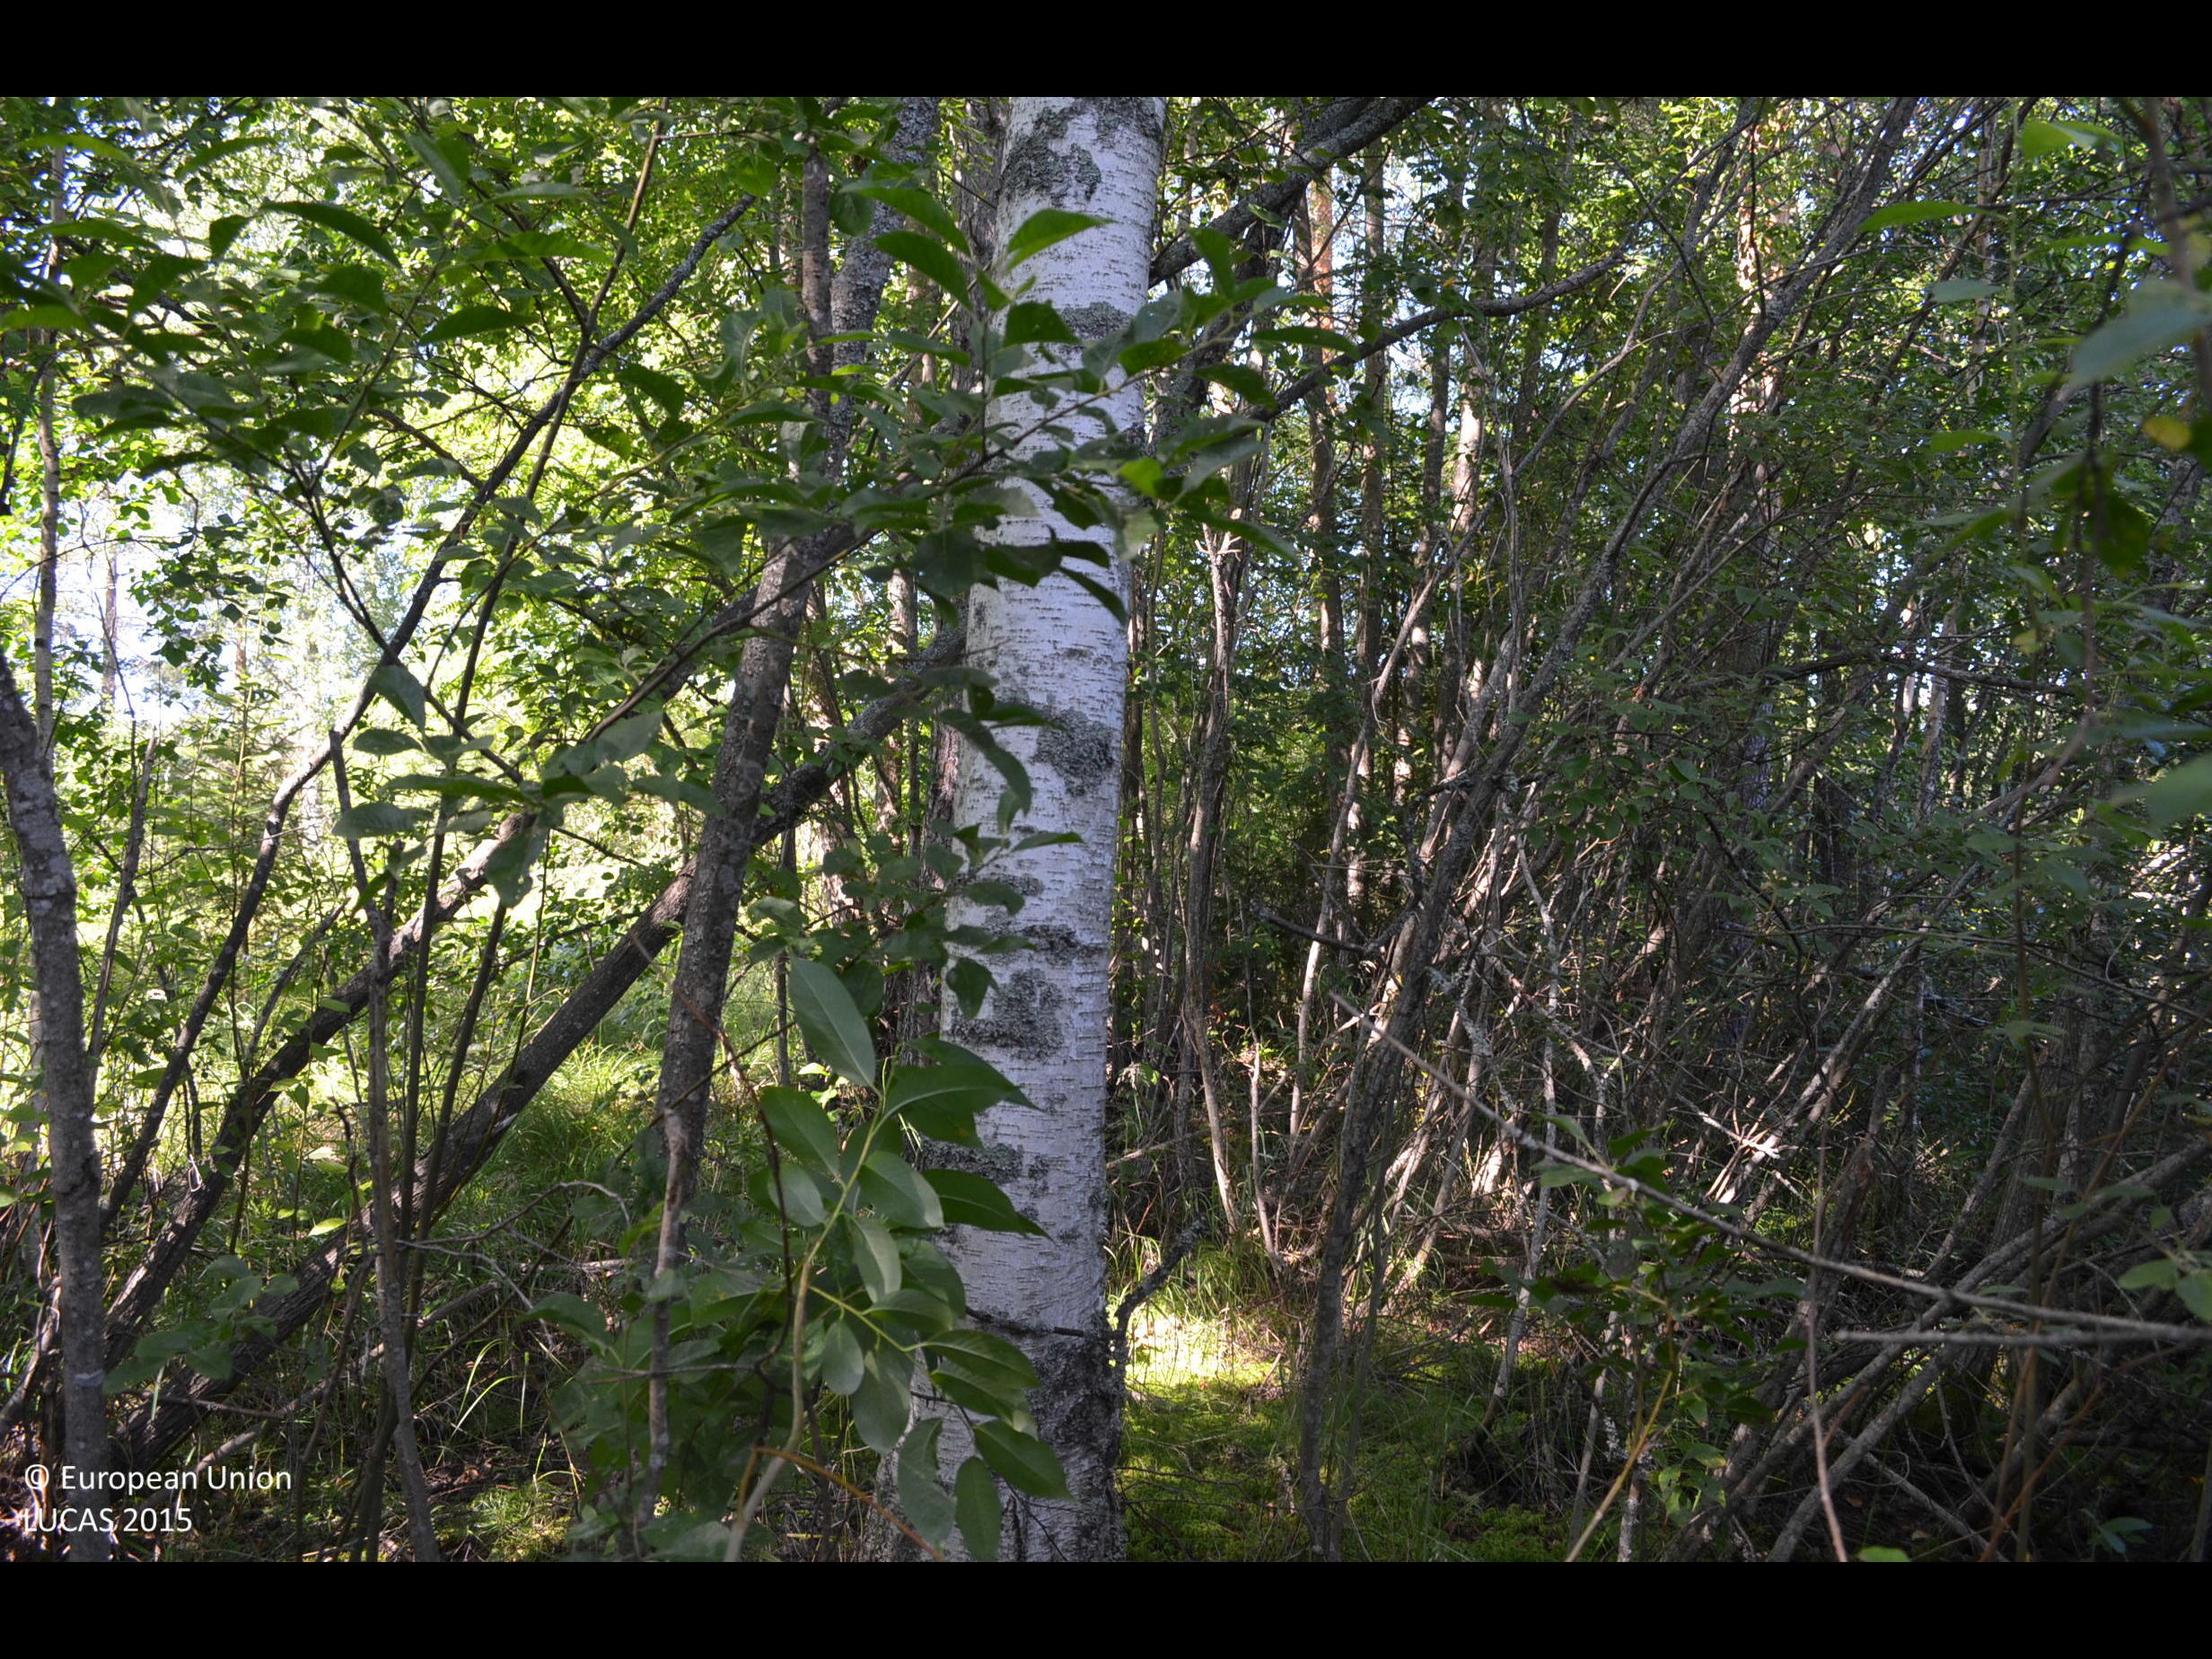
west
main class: Woodland
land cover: Broadleaved woodland
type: boreal forest
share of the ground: > 75 %
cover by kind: broadleaved forest trees 80 %, coniferous forest trees 10 %, lichens and mosses 10 %
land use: Semi-natural and natural areas not in use
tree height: > 5 m
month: August
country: FI
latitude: 62.1170
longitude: 24.2138
